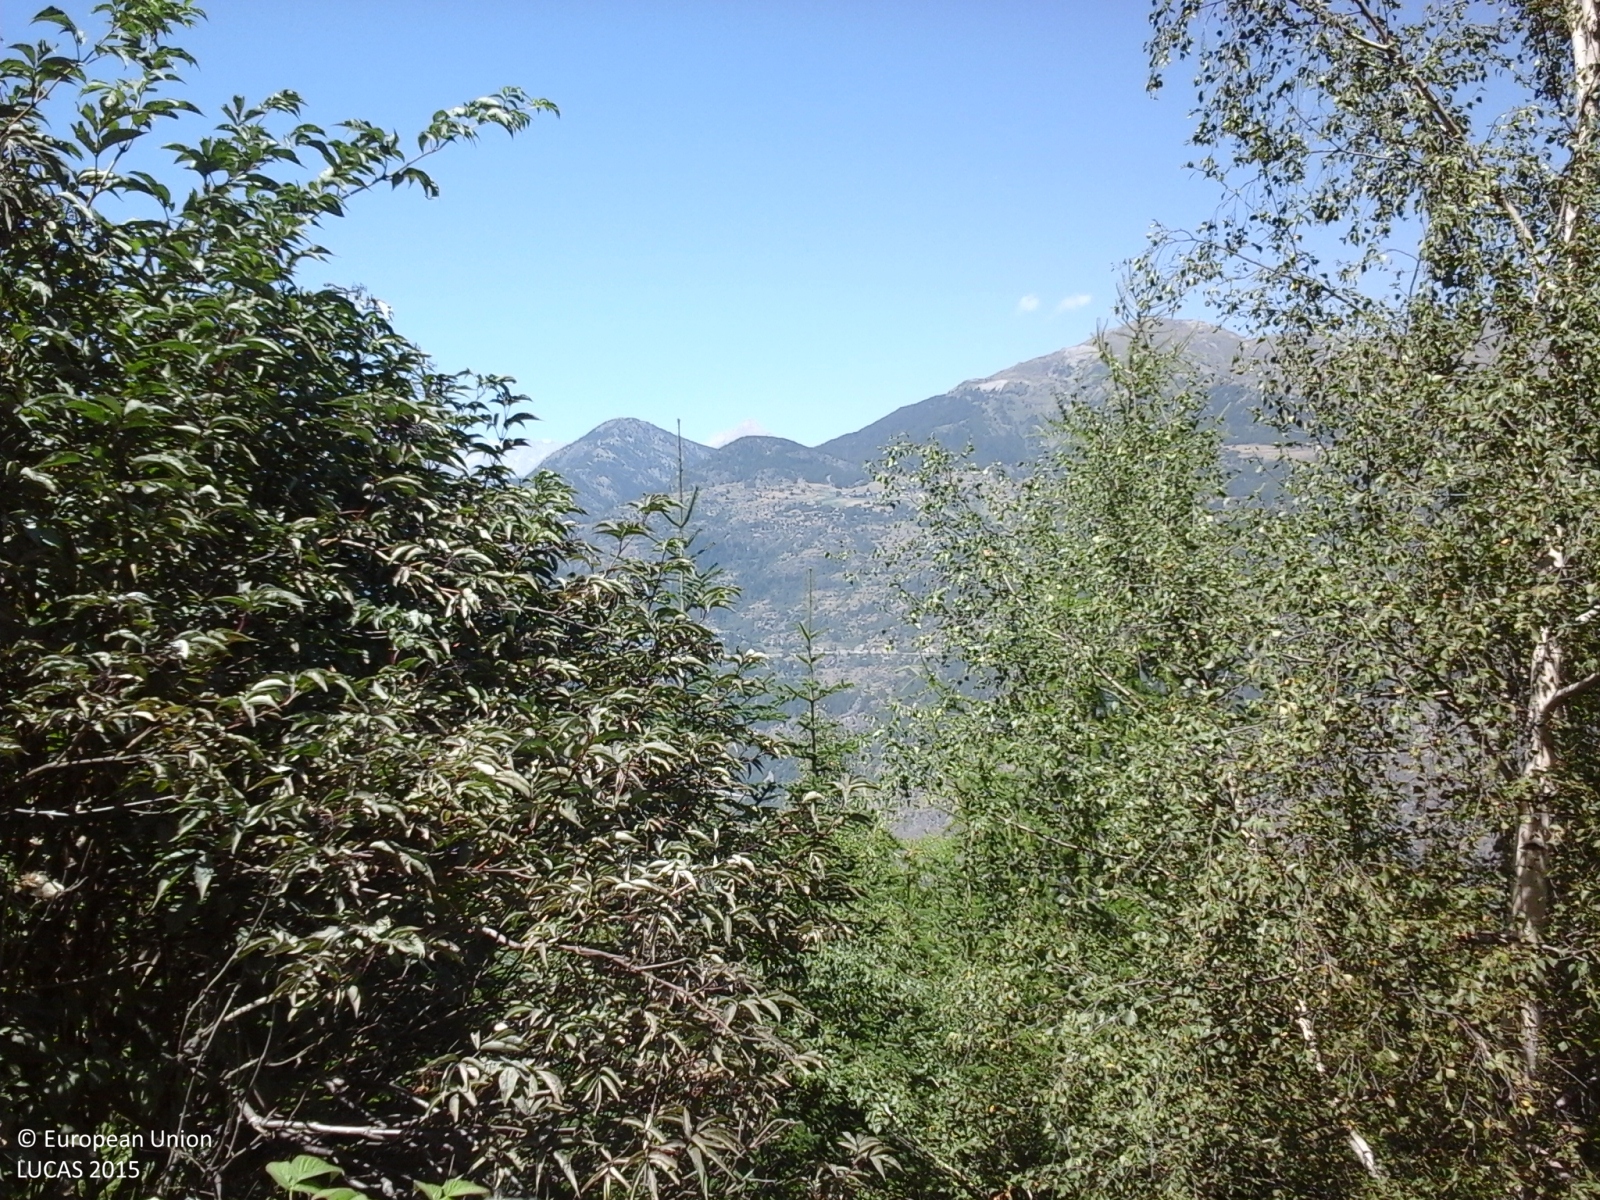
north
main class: Woodland
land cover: Spruce dominated mixed woodland
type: mesophytic deciduous forest
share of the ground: > 75 %
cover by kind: coniferous forest trees 50 %, broadleaved forest trees 40 %, shrubs 10 %
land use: Forestry
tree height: > 5 m
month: August
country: IT
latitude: 45.6828
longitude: 7.1664
